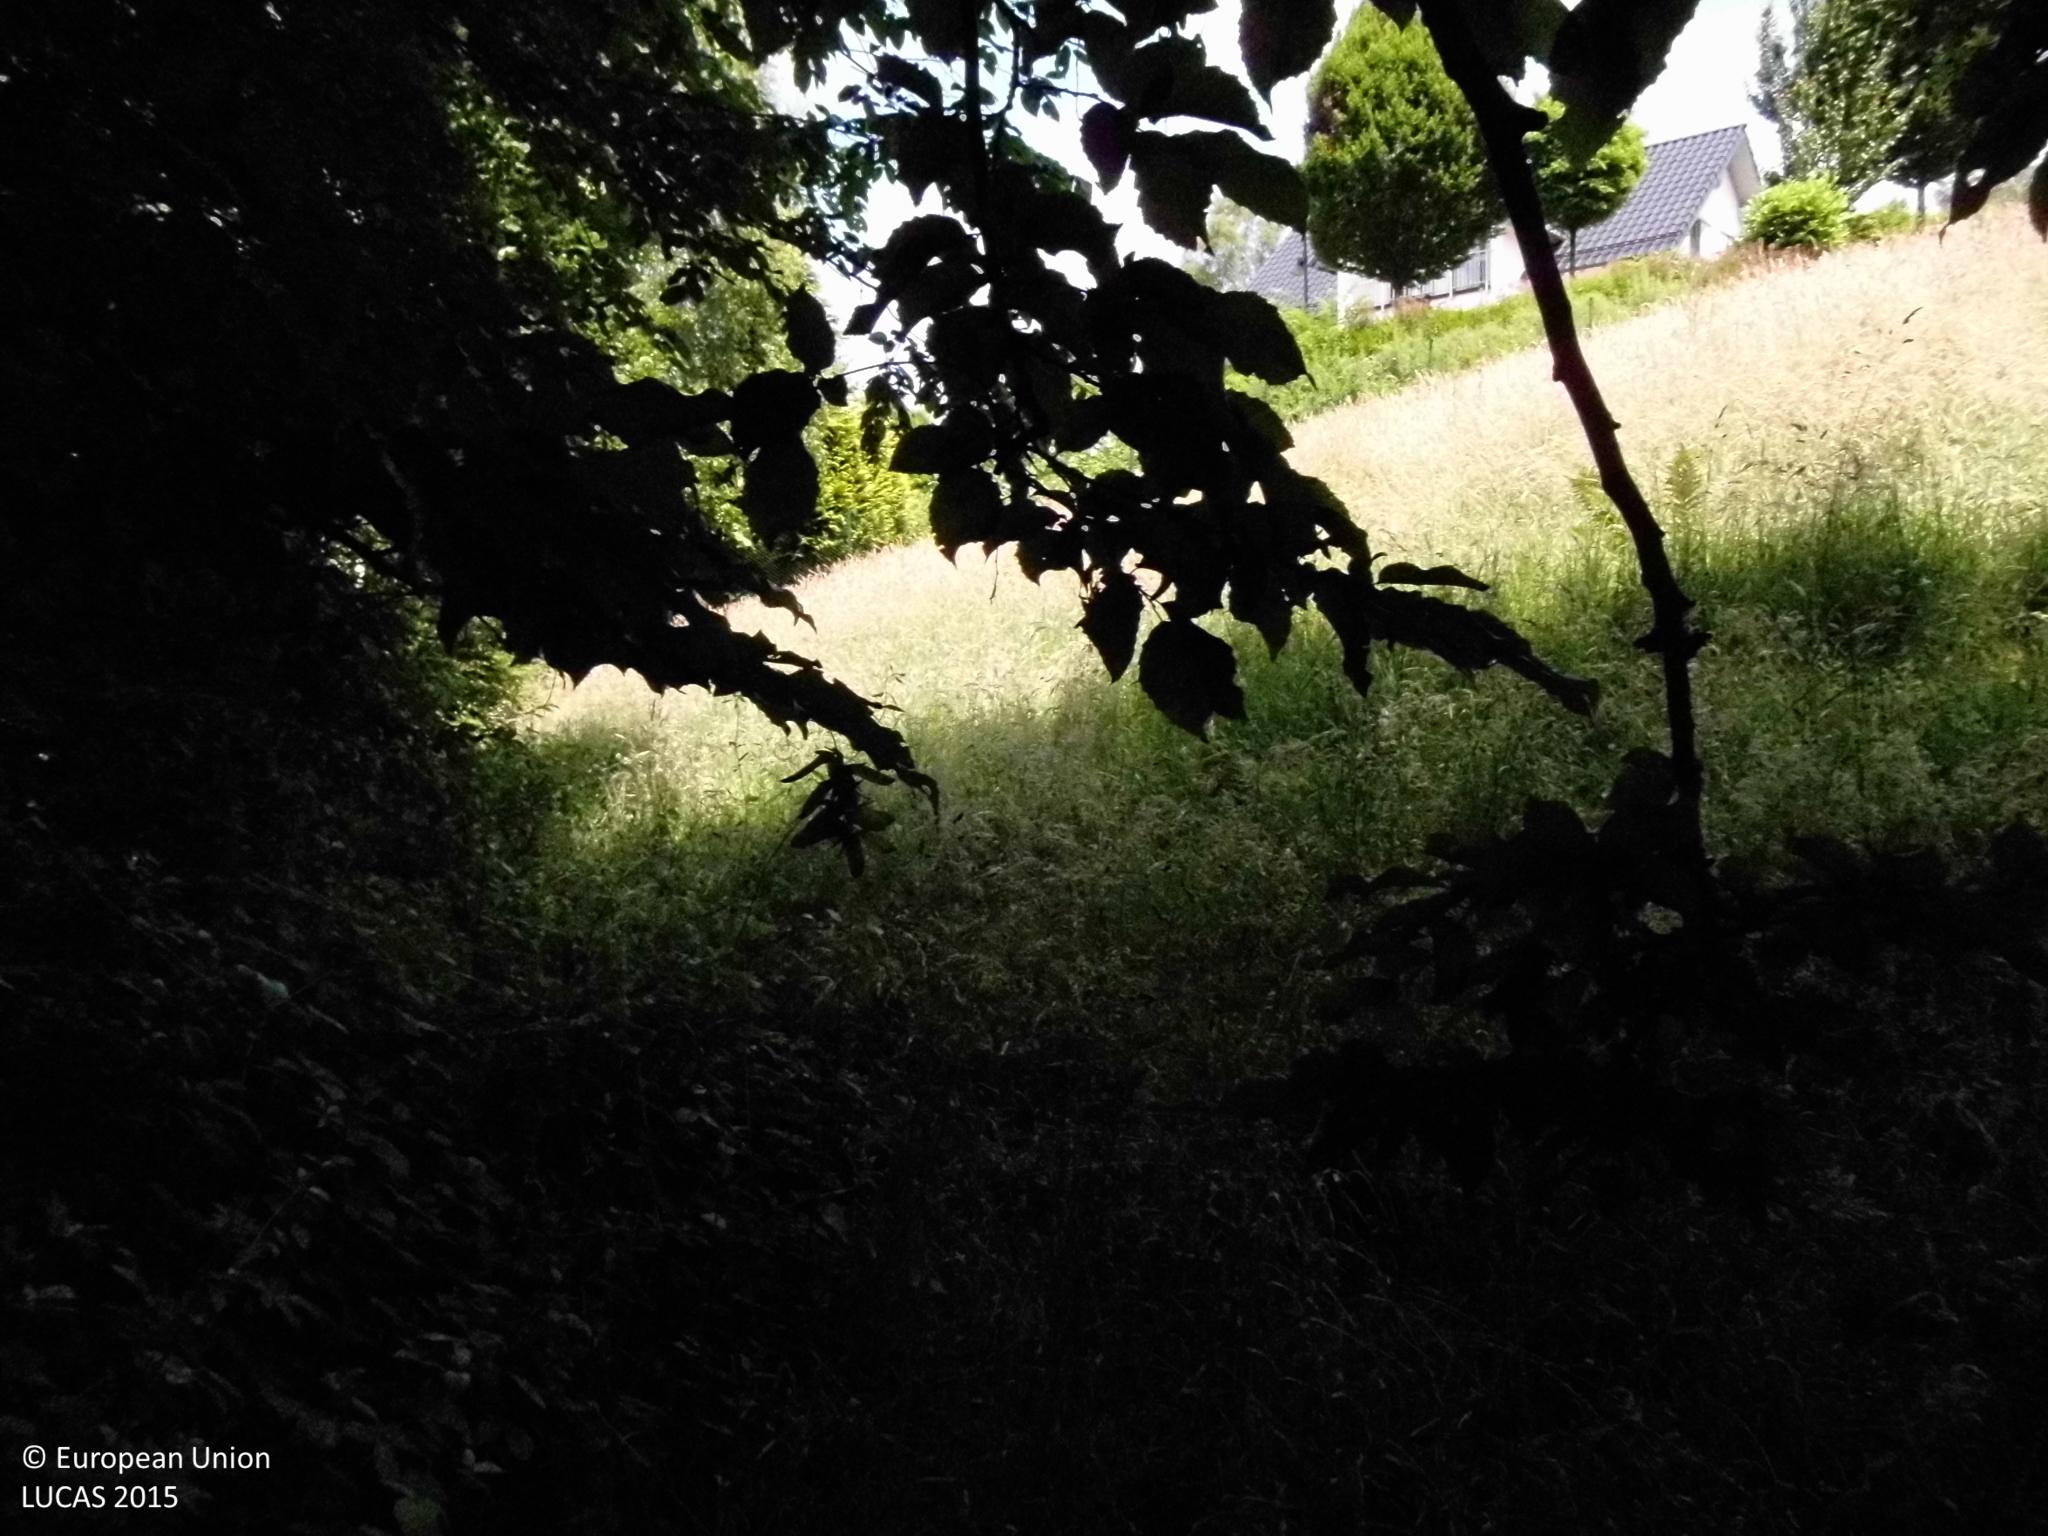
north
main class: Woodland
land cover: Broadleaved woodland
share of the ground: > 75 %
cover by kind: broadleaved forest trees 100 %
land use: Semi-natural and natural areas not in use
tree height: > 5 m
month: June
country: DE
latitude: 50.9826
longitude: 7.4220
